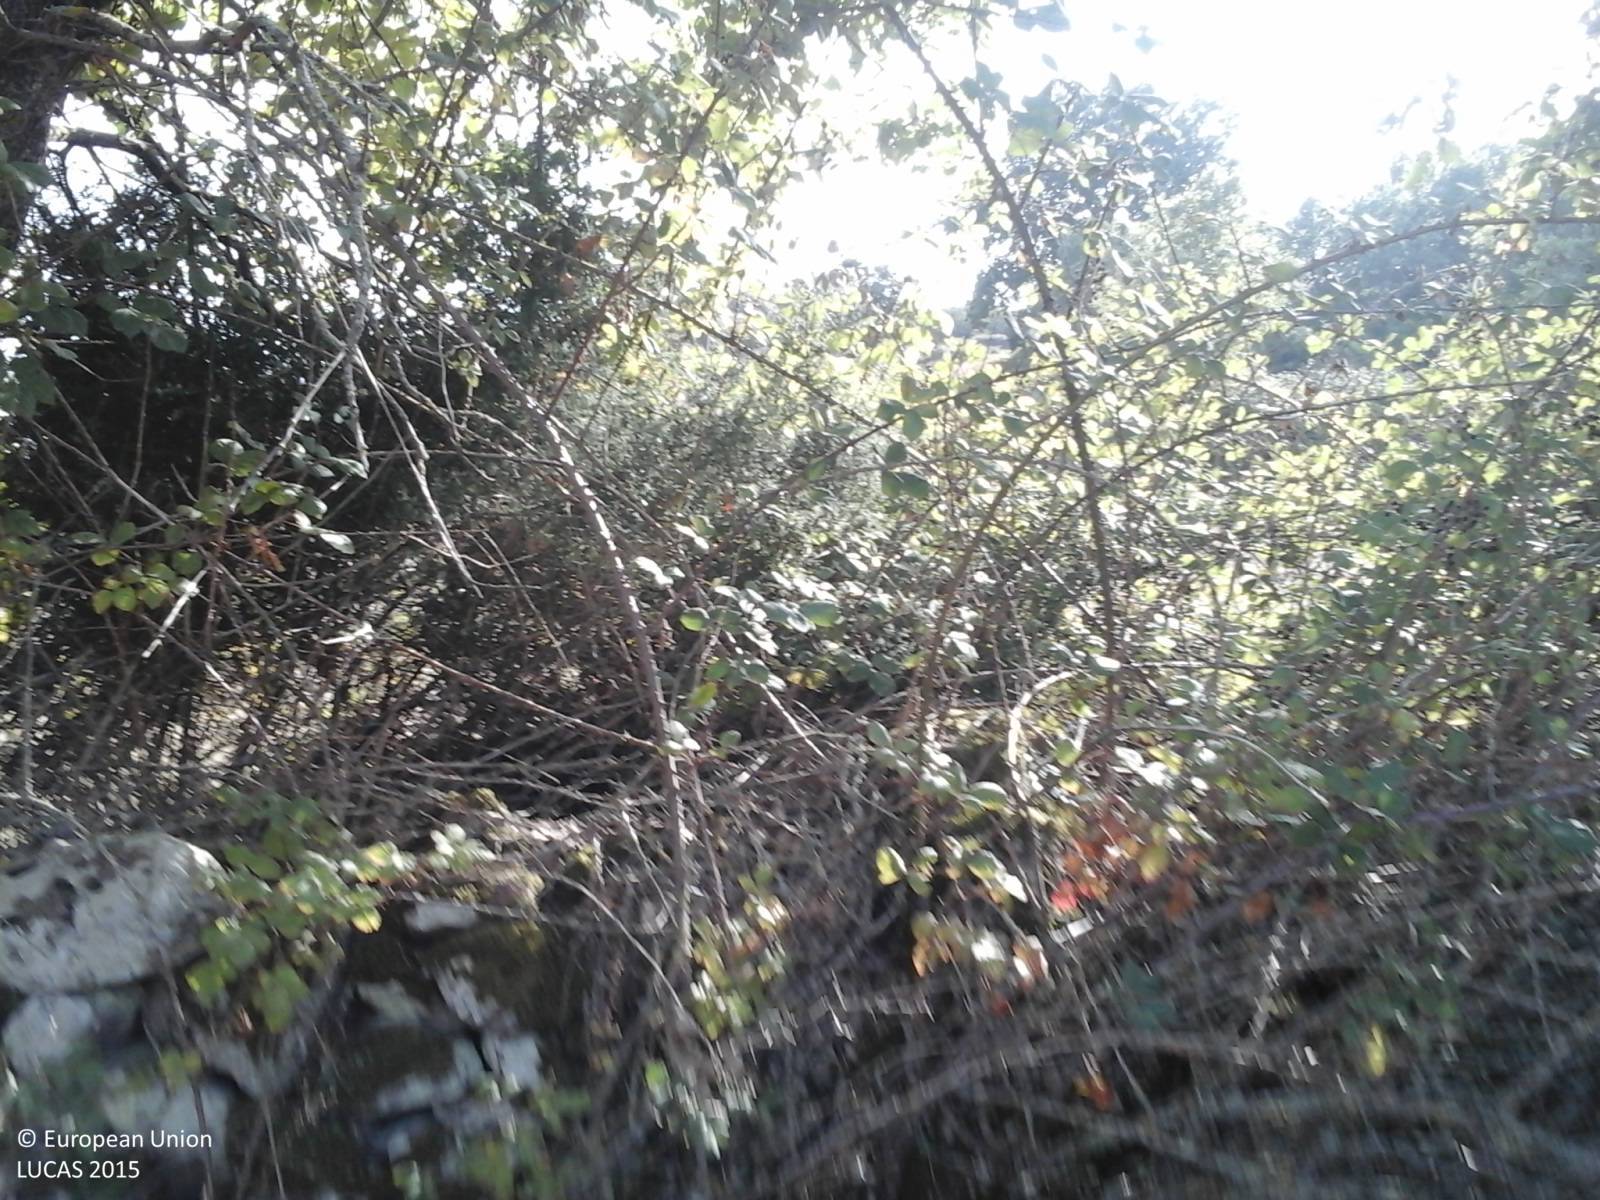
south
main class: Grassland
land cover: Grassland without tree/shrub cover
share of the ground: 25 - 50 %
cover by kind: herbaceous plants 100 %
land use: Agriculture (excluding fallow land and kitchen gardens)
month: October
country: IT
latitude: 40.2964
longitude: 8.8180
